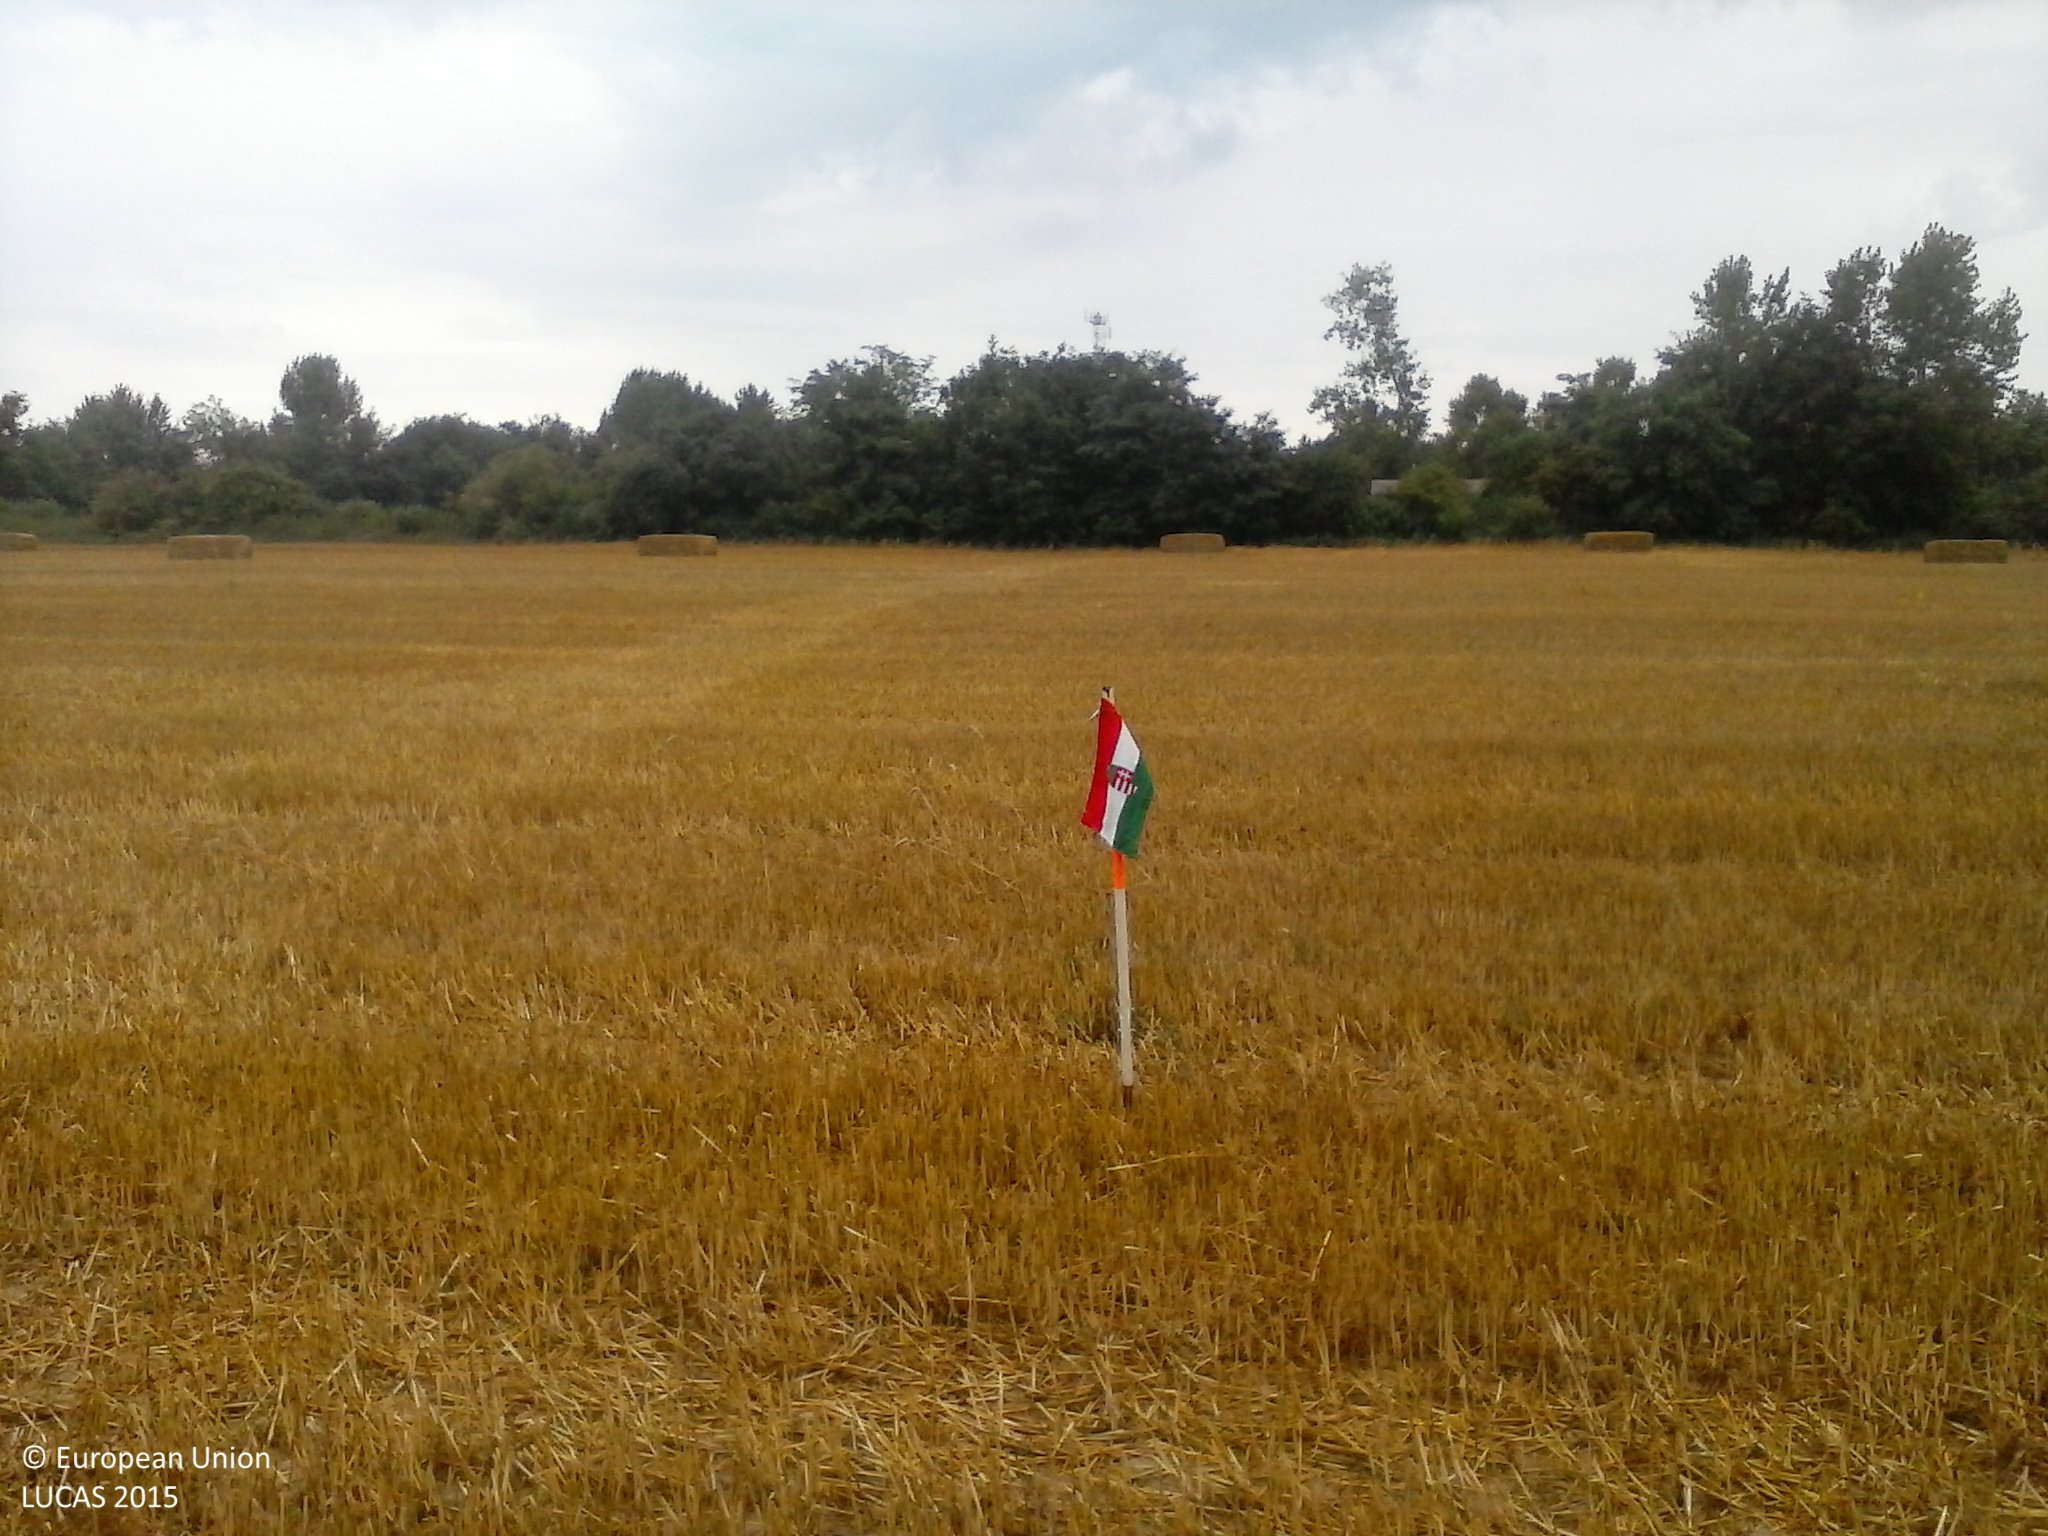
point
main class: Cropland
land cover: Durum wheat
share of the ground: > 75 %
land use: Agriculture (excluding fallow land and kitchen gardens)
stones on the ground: < 10 %
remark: Harvested field
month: July
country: HU
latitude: 46.0396
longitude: 17.6667
